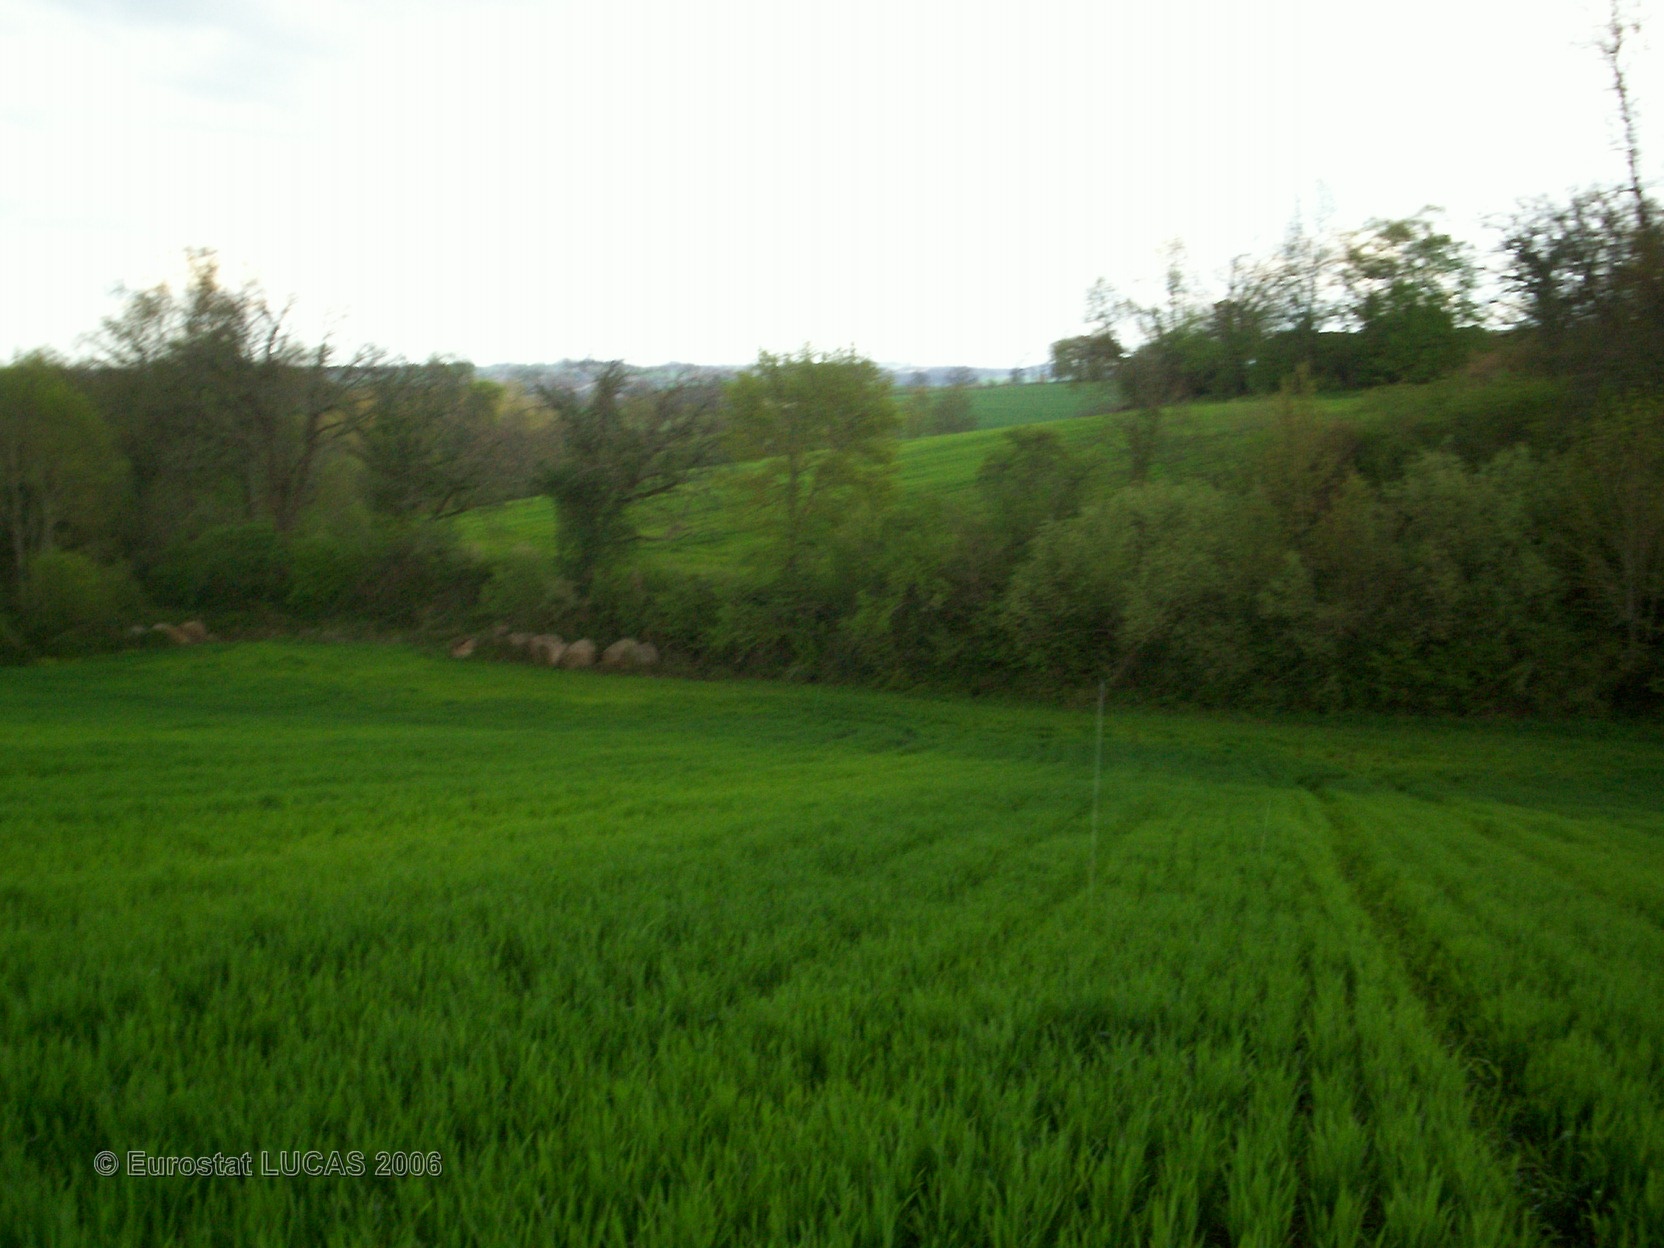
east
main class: Cropland
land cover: Common wheat
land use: Agriculture (excluding fallow land and kitchen gardens)
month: April
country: FR
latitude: 43.9546
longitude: 0.1609
